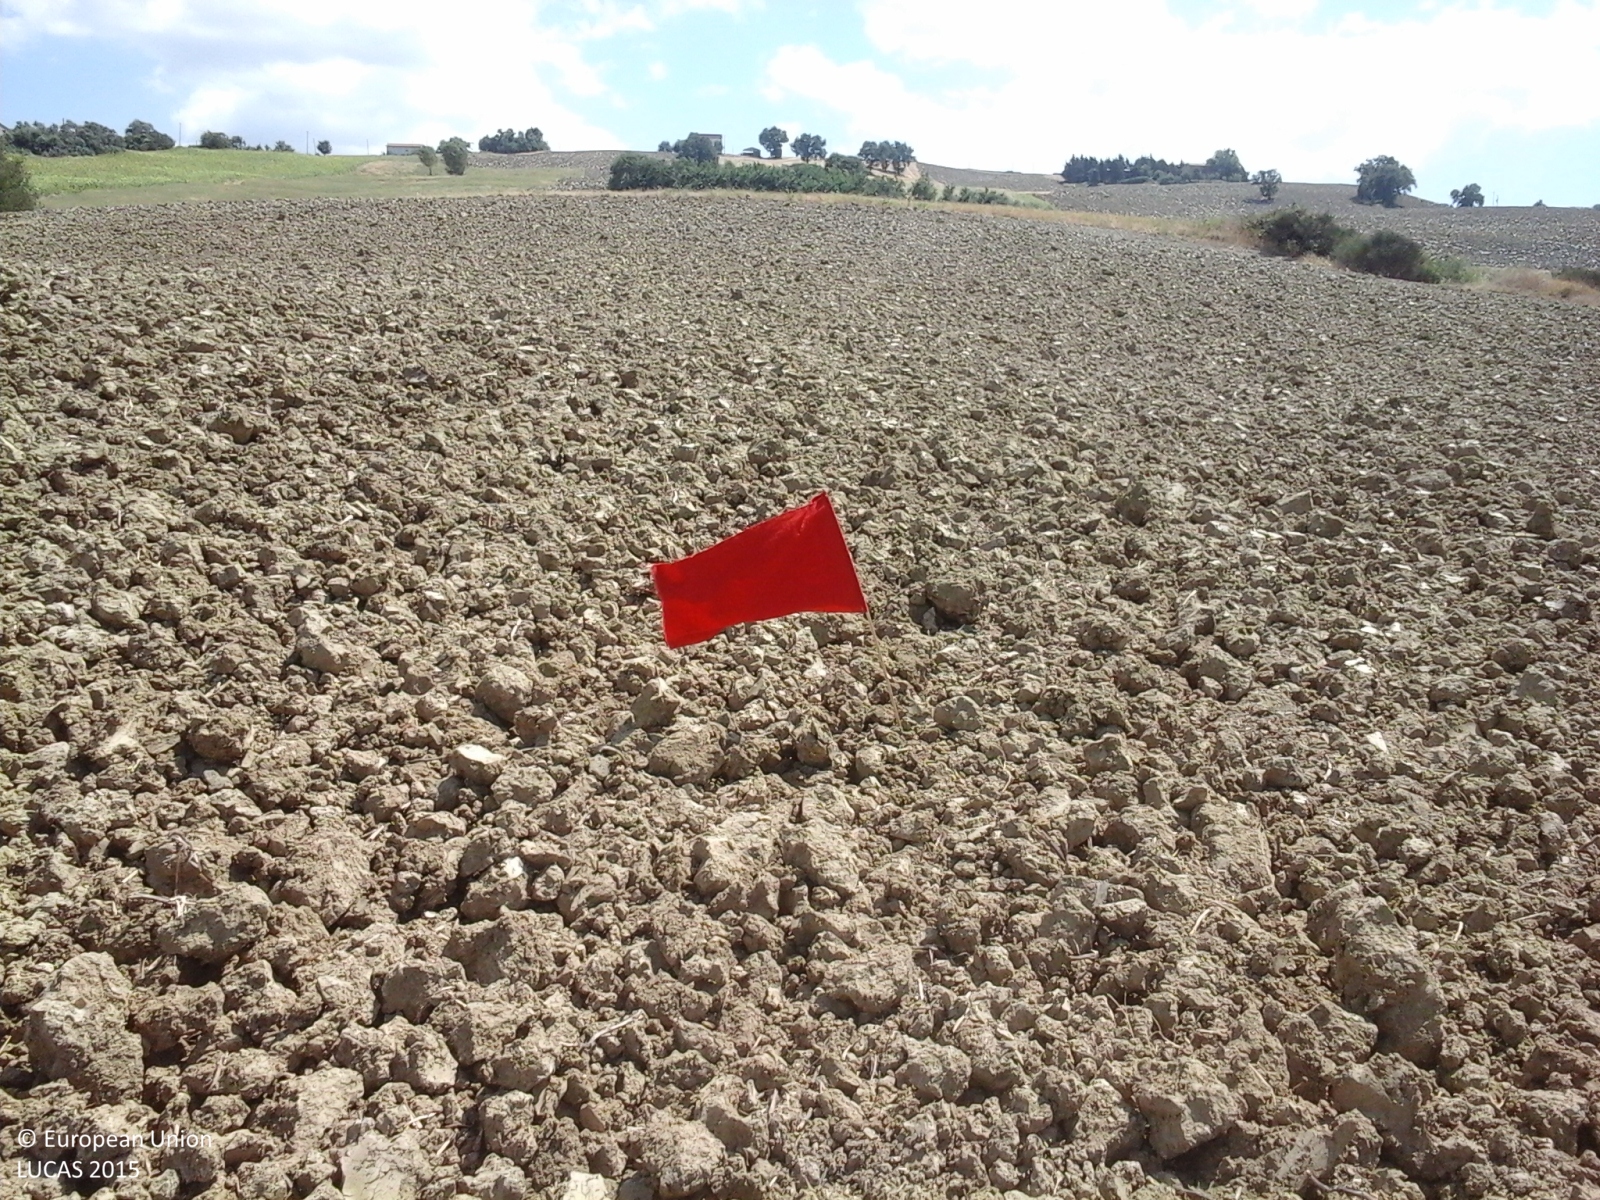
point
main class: Cropland
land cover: Durum wheat
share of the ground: > 75 %
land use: Agriculture (excluding fallow land and kitchen gardens)
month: July
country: IT
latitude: 43.2342
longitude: 13.2545
